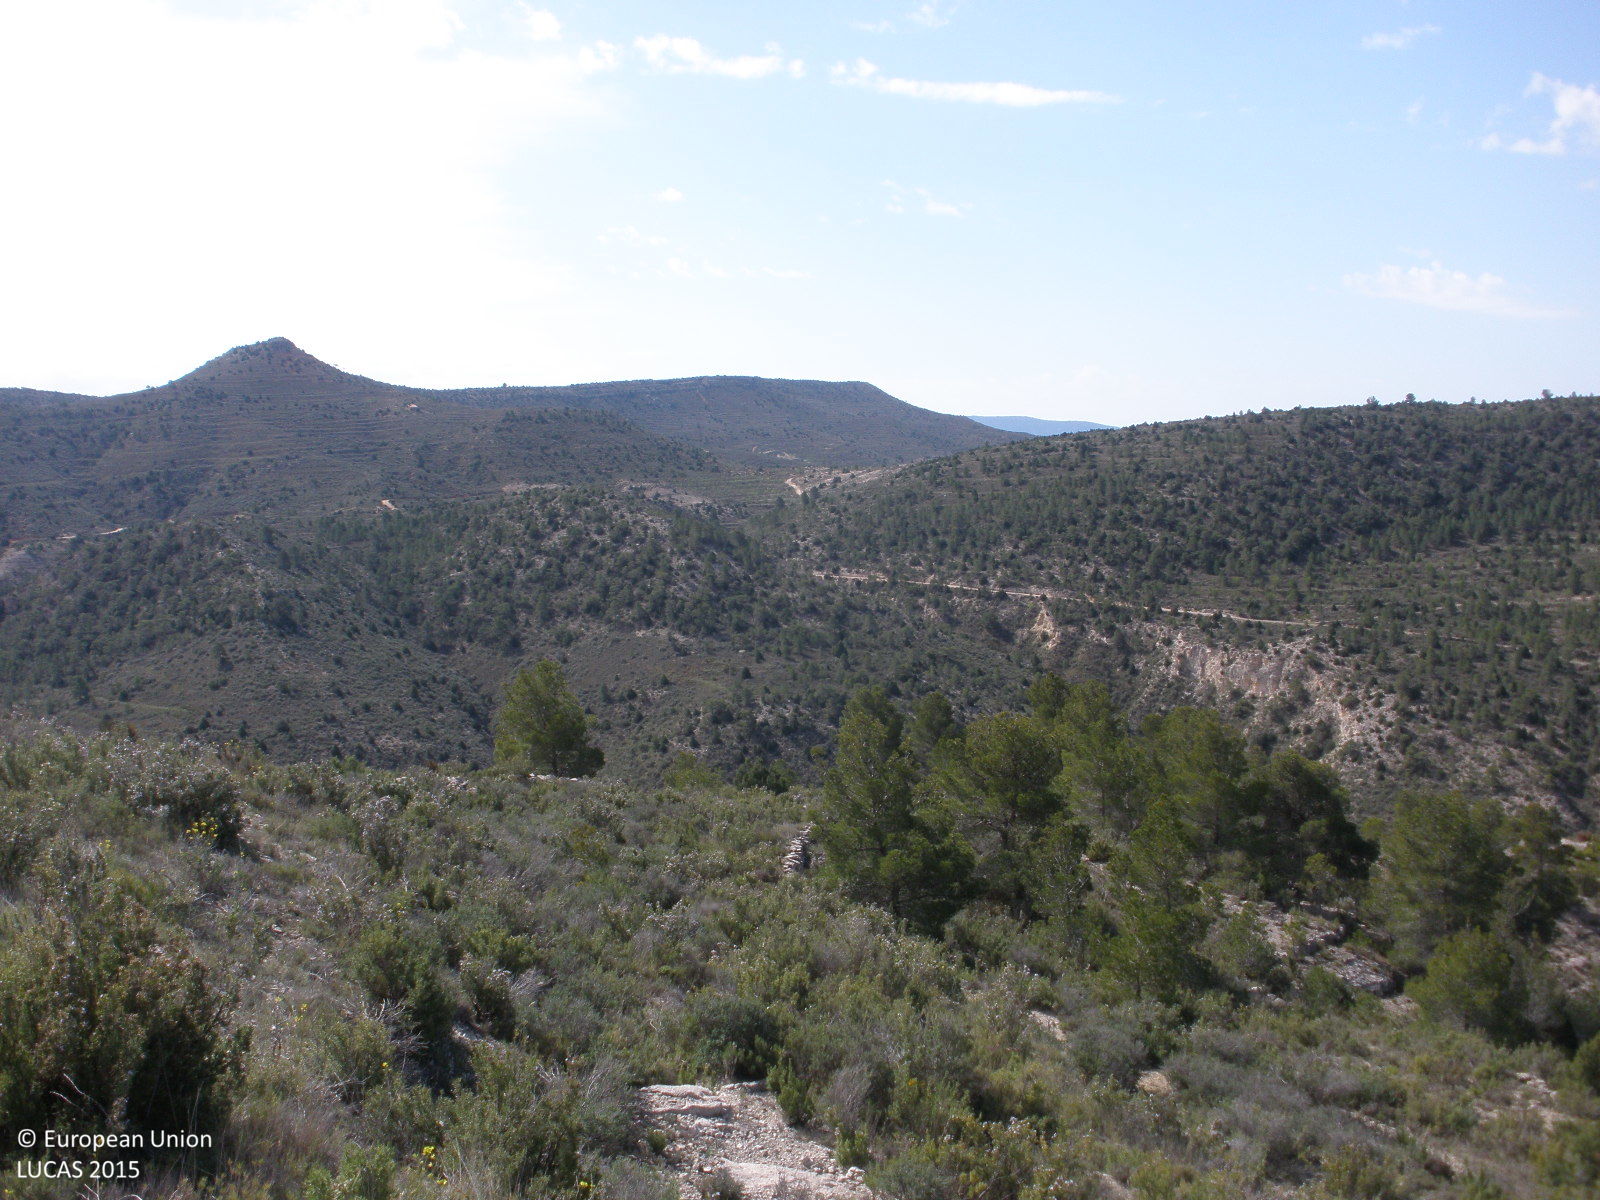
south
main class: Shrubland
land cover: Shrubland without tree cover
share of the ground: > 75 %
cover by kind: shrubs 80 %, consolidated bare surface 20 %
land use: Semi-natural and natural areas not in use
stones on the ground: 25 - 50 %
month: April
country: ES
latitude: 40.1534
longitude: -1.1971
